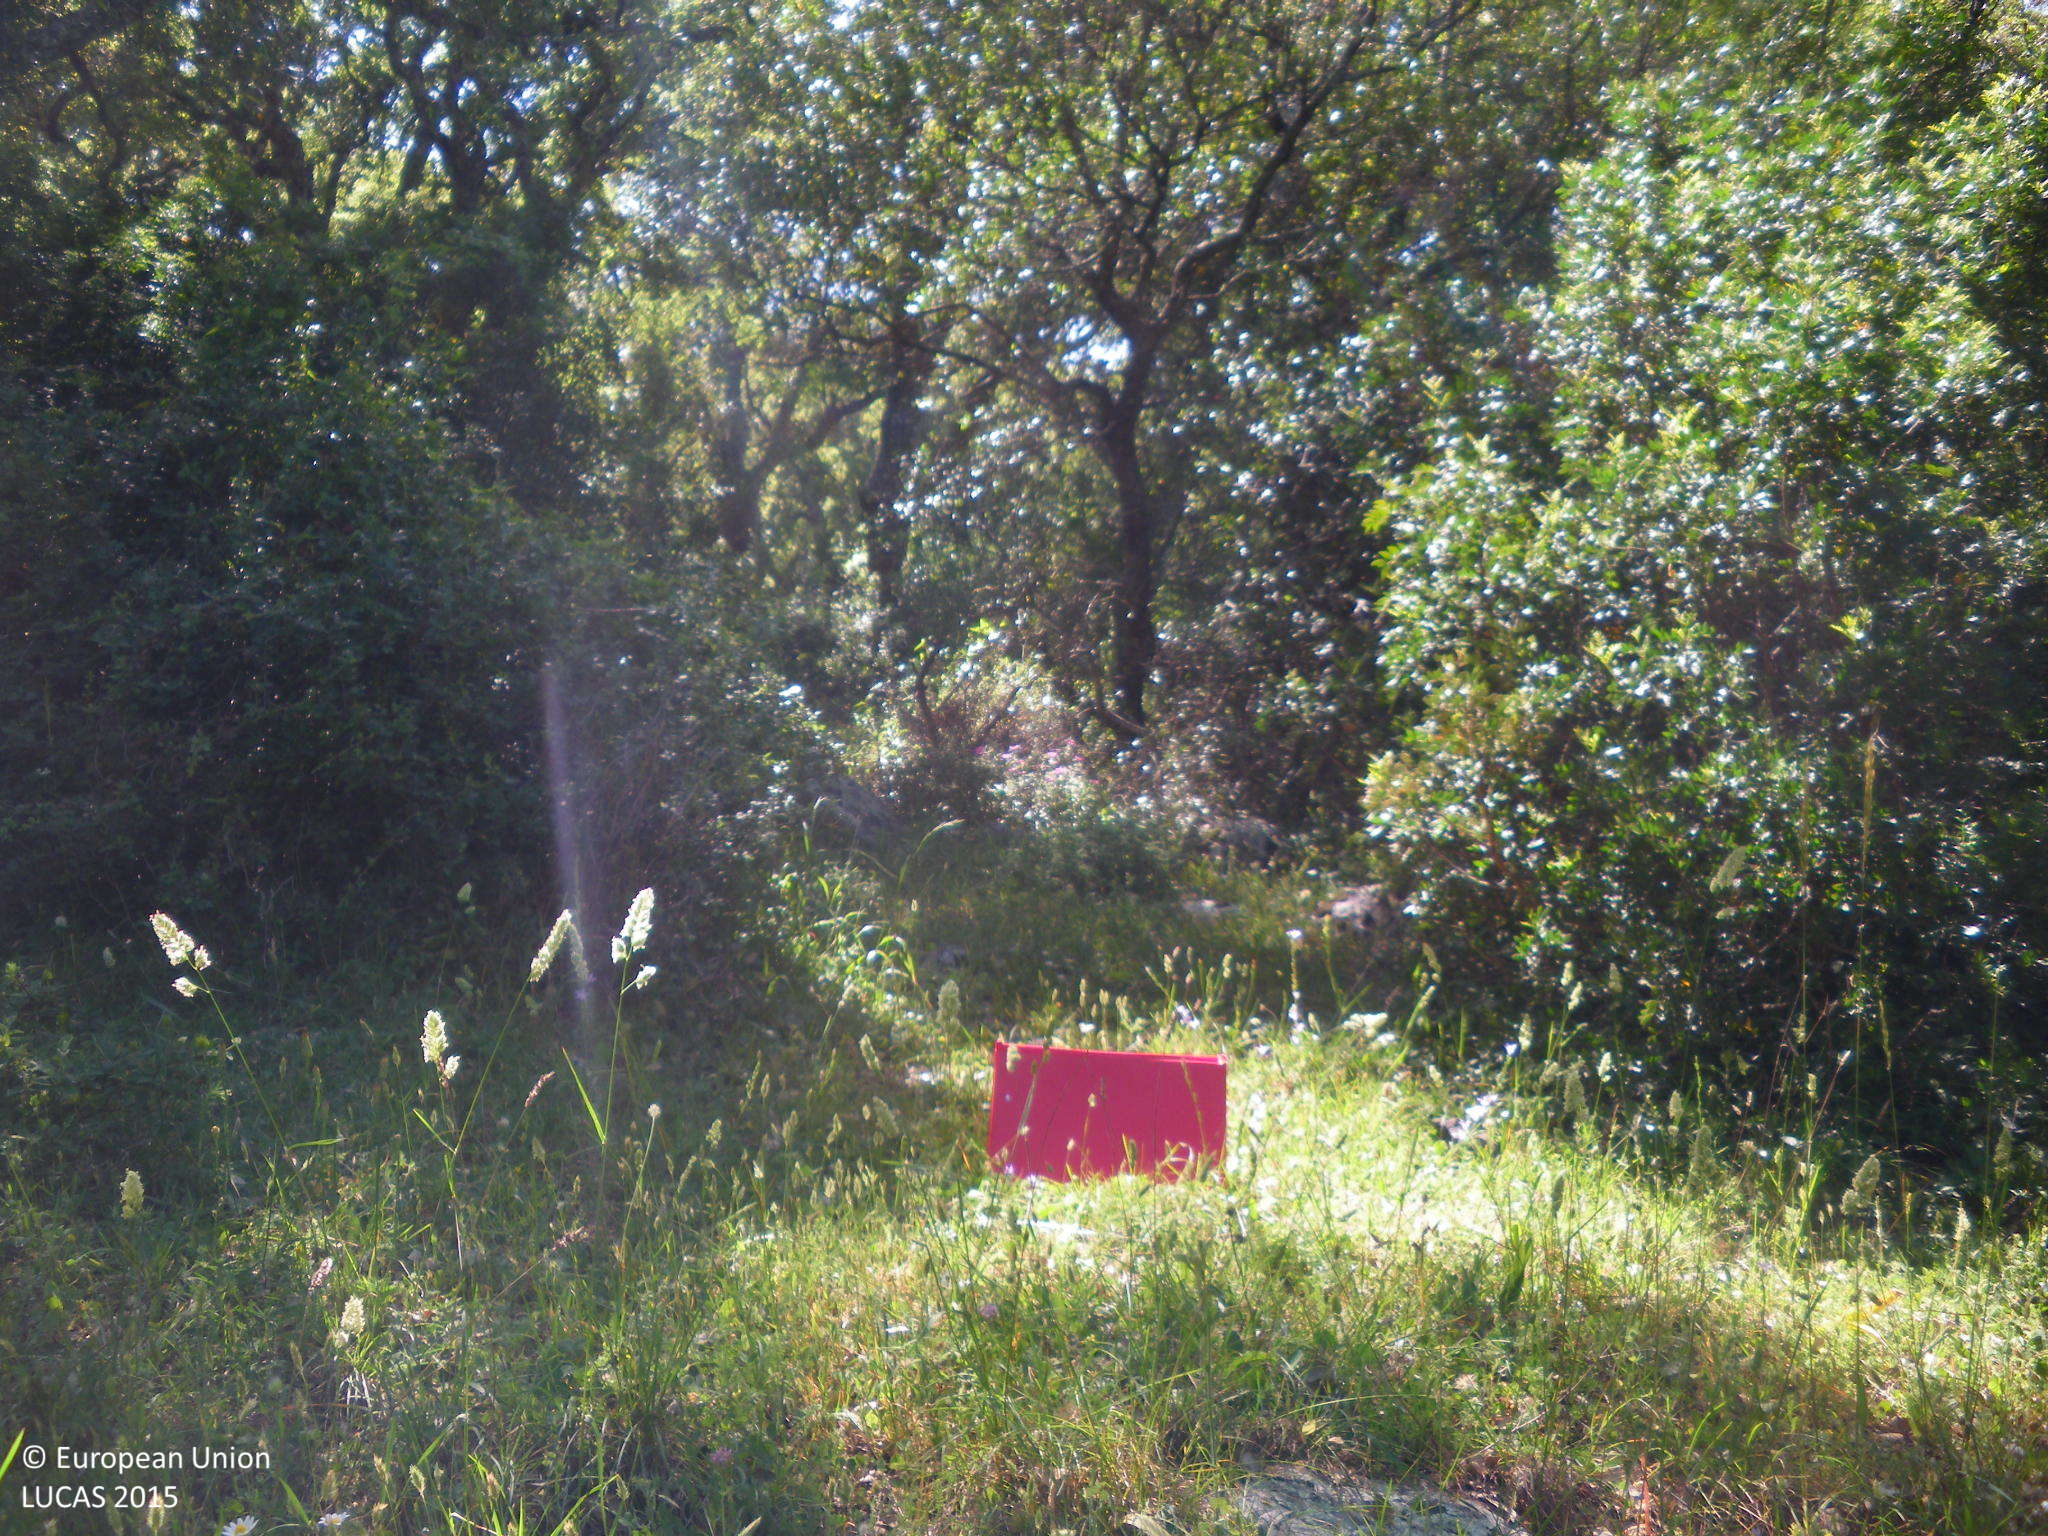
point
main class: Woodland
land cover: Broadleaved woodland
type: broadleaved evergreen forest
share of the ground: > 75 %
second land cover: Shrubland without tree cover
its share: 25 - 50 %
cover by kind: broadleaved forest trees 90 %, shrubs 10 %
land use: Forestry
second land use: Agriculture (excluding fallow land and kitchen gardens)
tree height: > 5 m
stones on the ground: < 10 %
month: May
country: ES
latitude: 36.5174
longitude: -5.6462
